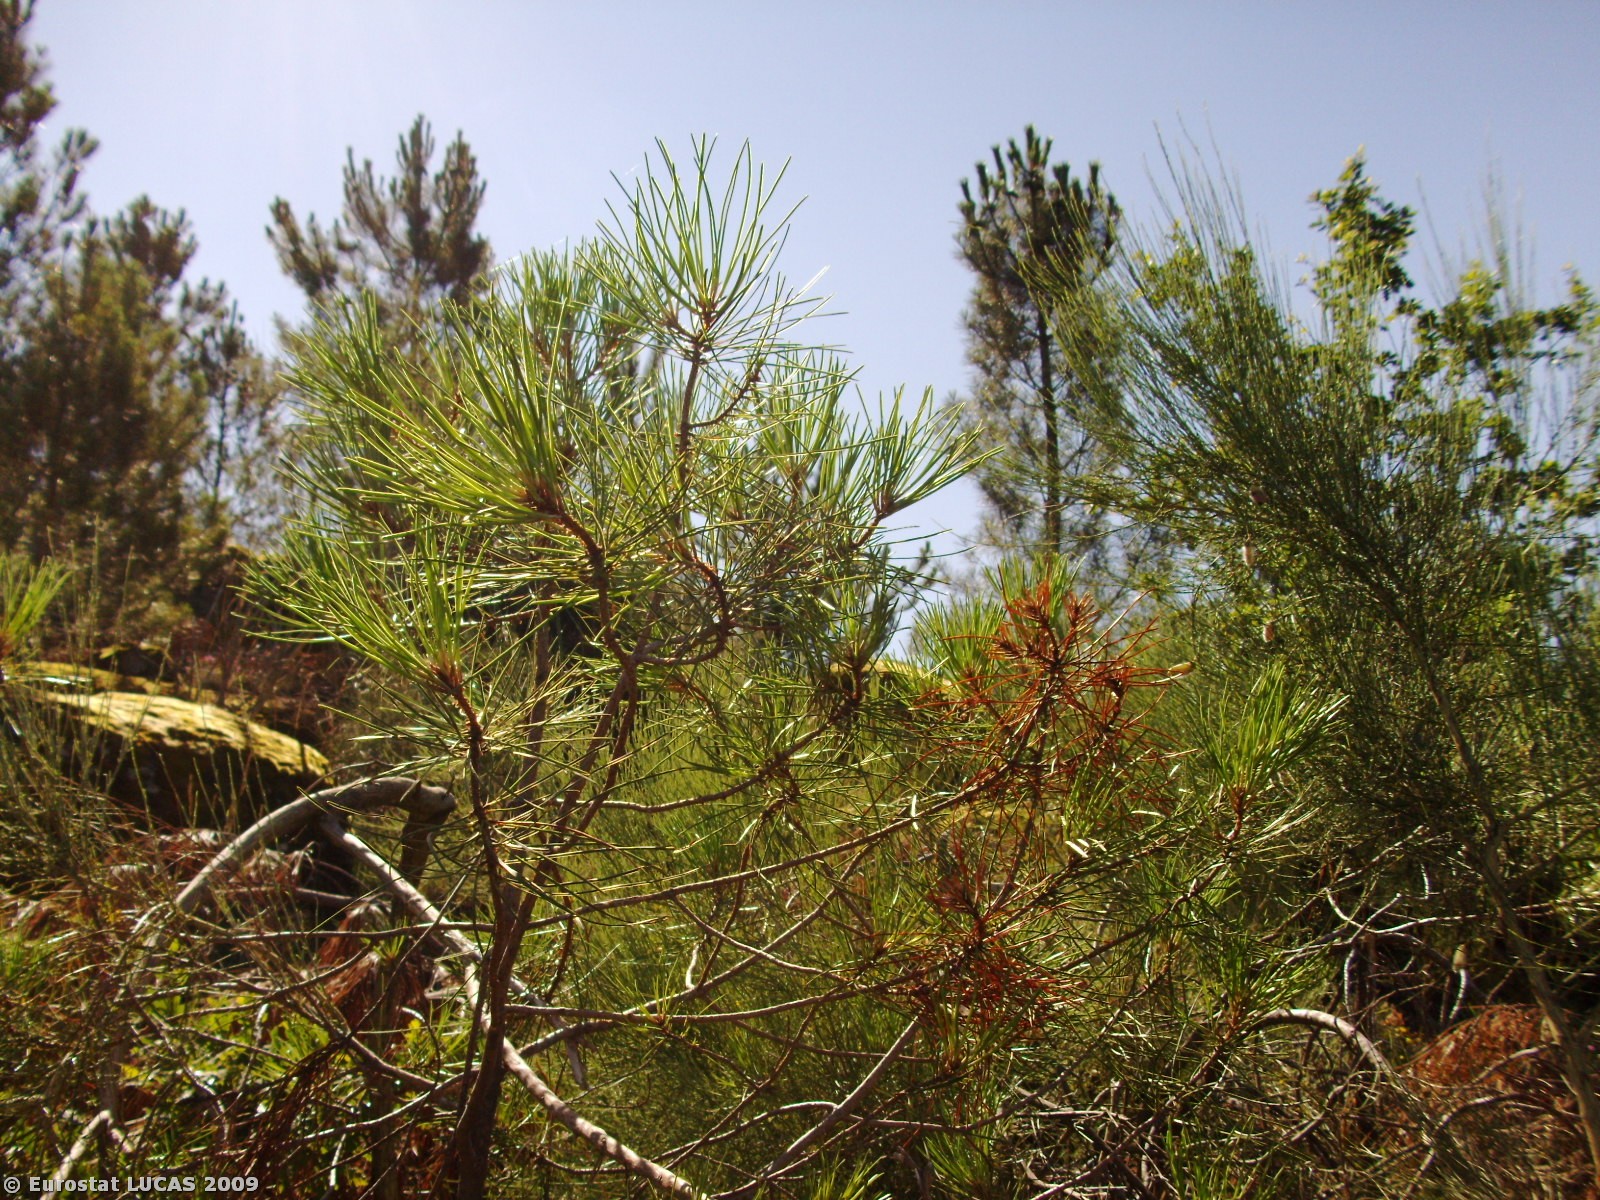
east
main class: Woodland
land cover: Coniferous woodland
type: coniferous forest of the mediterranean region
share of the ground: 10 - 25 %
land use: Forestry
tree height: > 5 m
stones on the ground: < 10 %
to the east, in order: Coniferous woodland; Rock outcrops; Coniferous woodland; Broadleaved woodland; Shrubland without tree cover; Tracks; Coniferous woodland; Tracks; Coniferous woodland
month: June
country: PT
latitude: 40.3968
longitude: -7.7046
